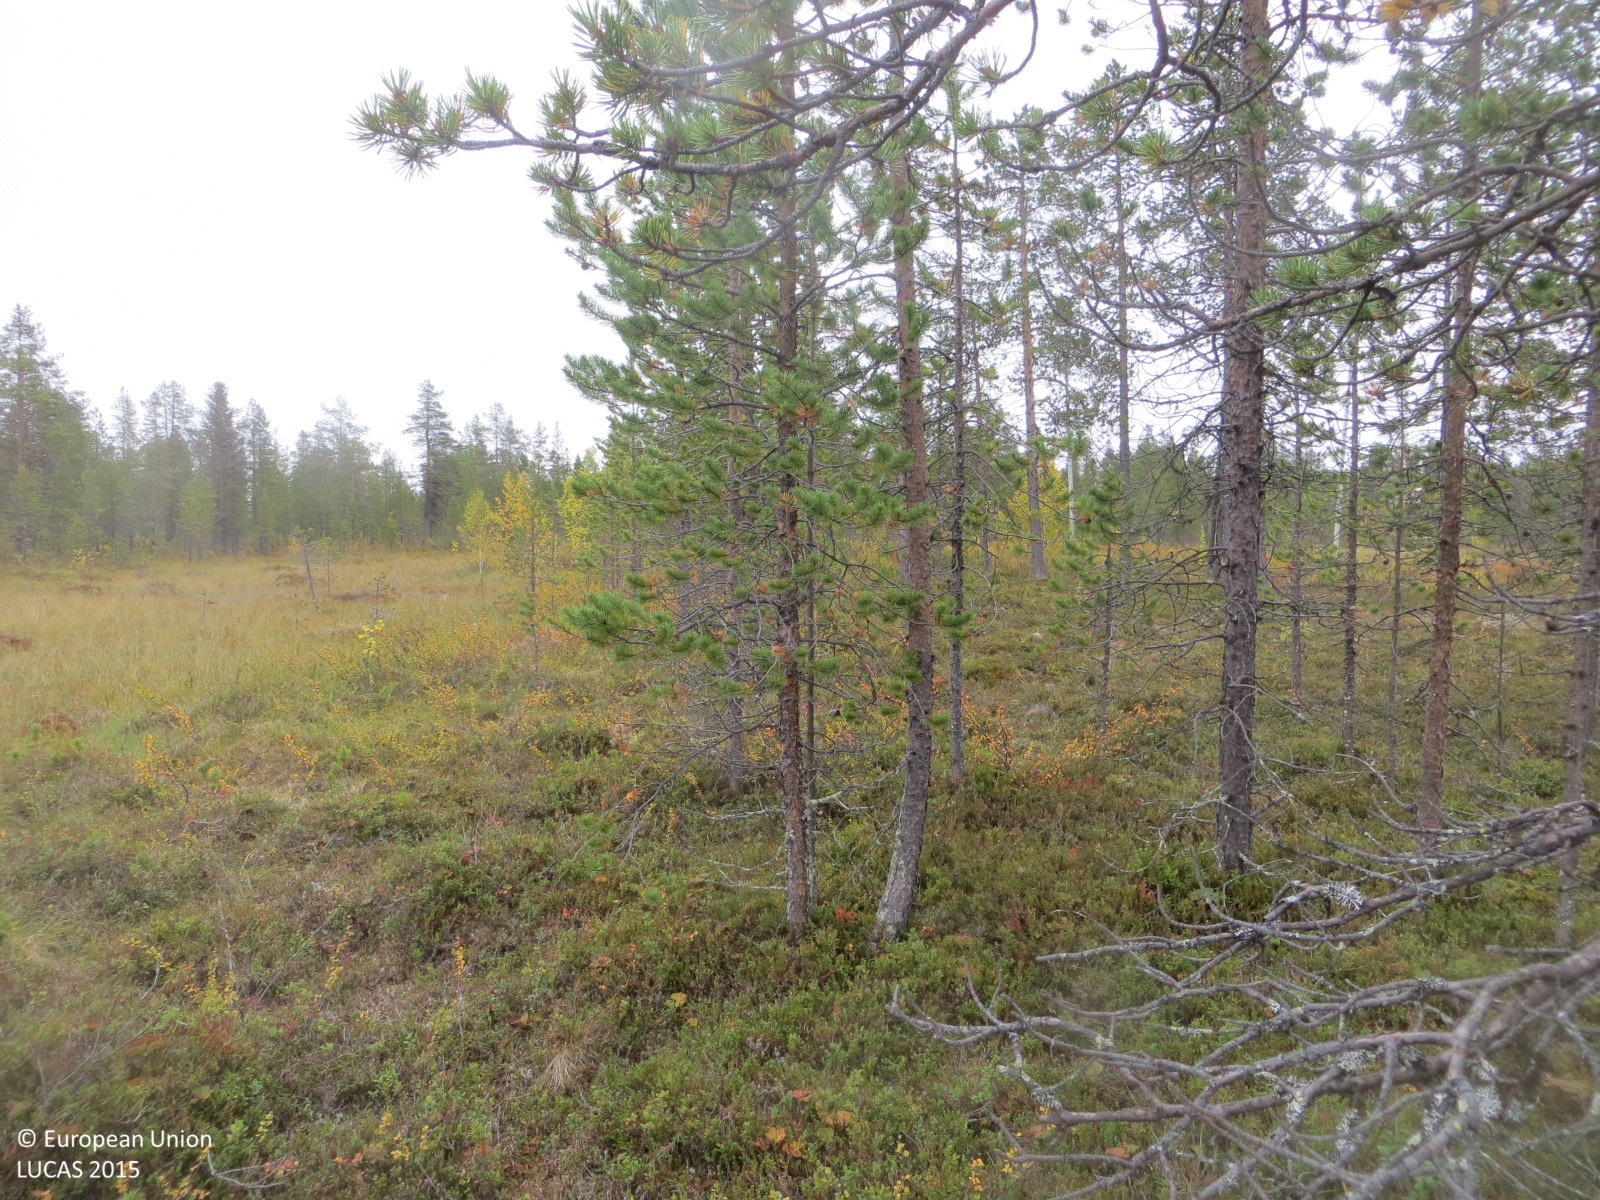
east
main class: Woodland
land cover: Pine dominated coniferous woodland
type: mire and swamp forests
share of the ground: 50 - 75 %
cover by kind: coniferous forest trees 55 %, shrubs 45 %
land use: Forestry
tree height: > 5 m
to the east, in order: Pine dominated coniferous woodland; Peatbogs; Pine dominated coniferous woodland; Shrubland with sparse tree cover; Broadleaved woodland
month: September
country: FI
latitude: 68.3366
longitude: 22.9360
